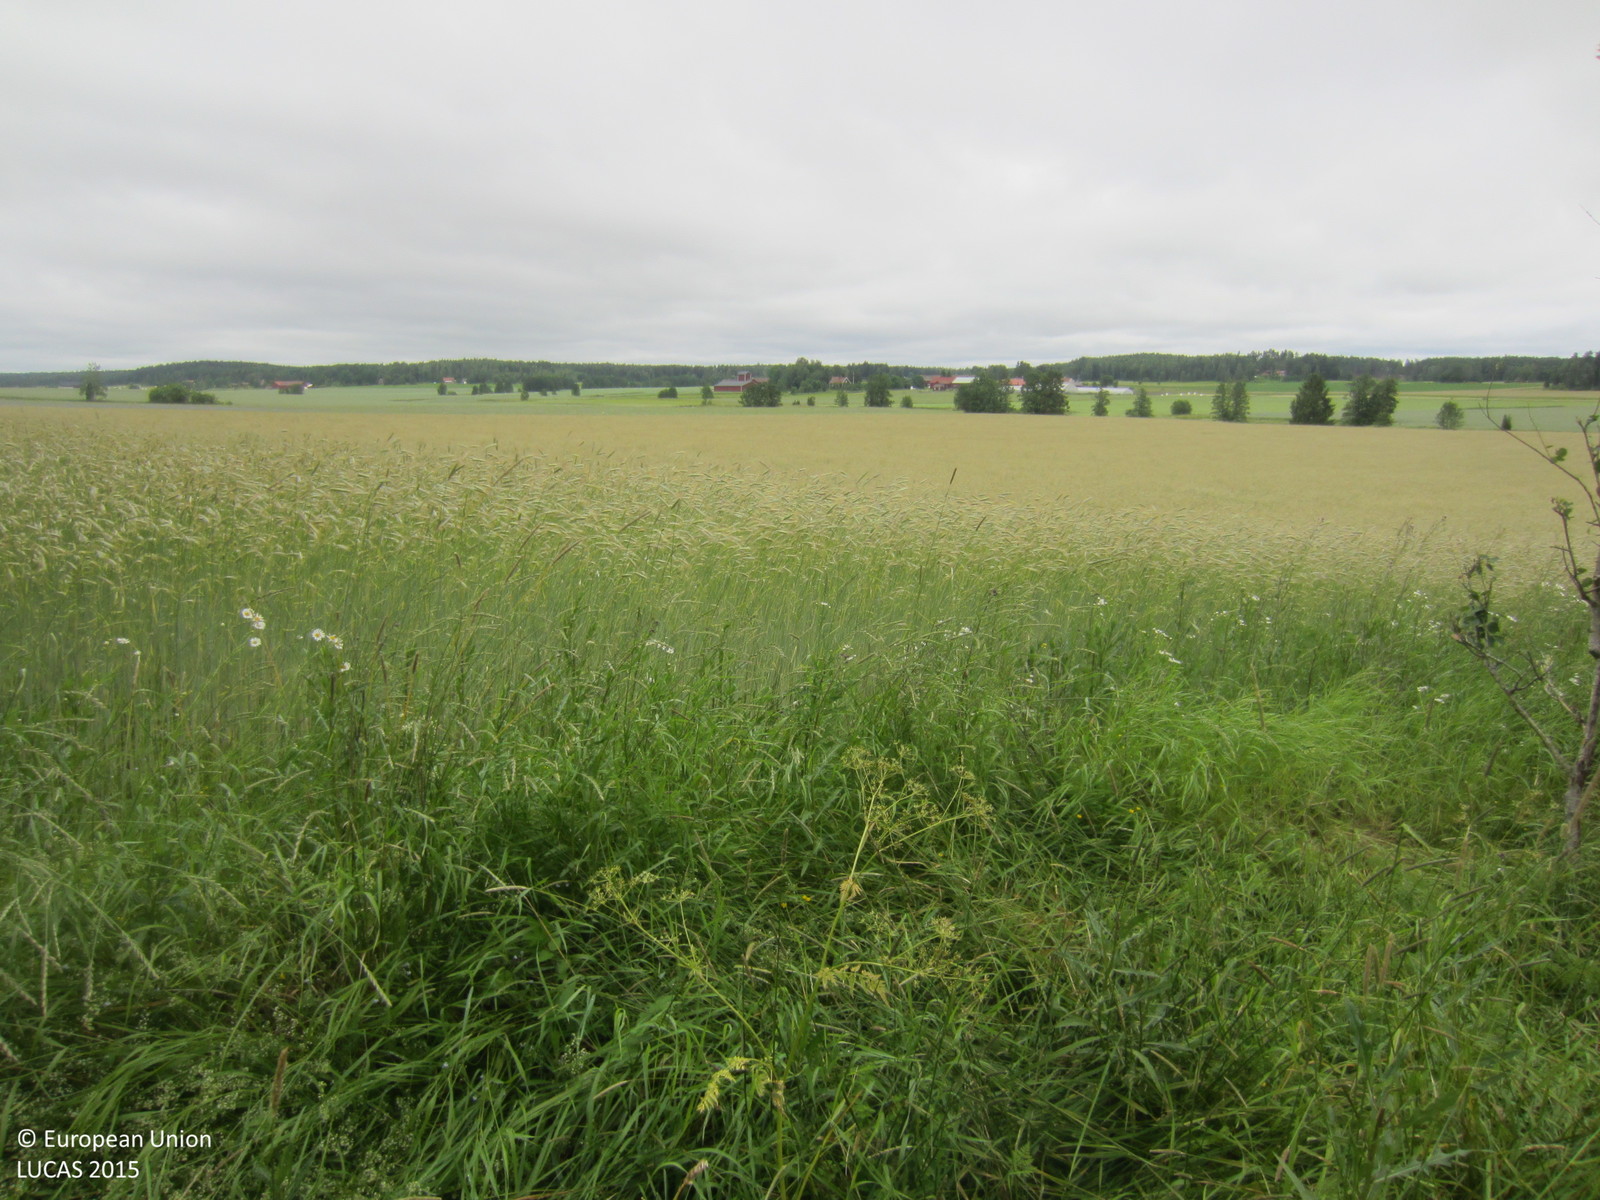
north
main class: Cropland
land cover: Rye
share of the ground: > 75 %
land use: Agriculture (excluding fallow land and kitchen gardens)
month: July
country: SE
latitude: 59.7884
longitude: 17.0302
